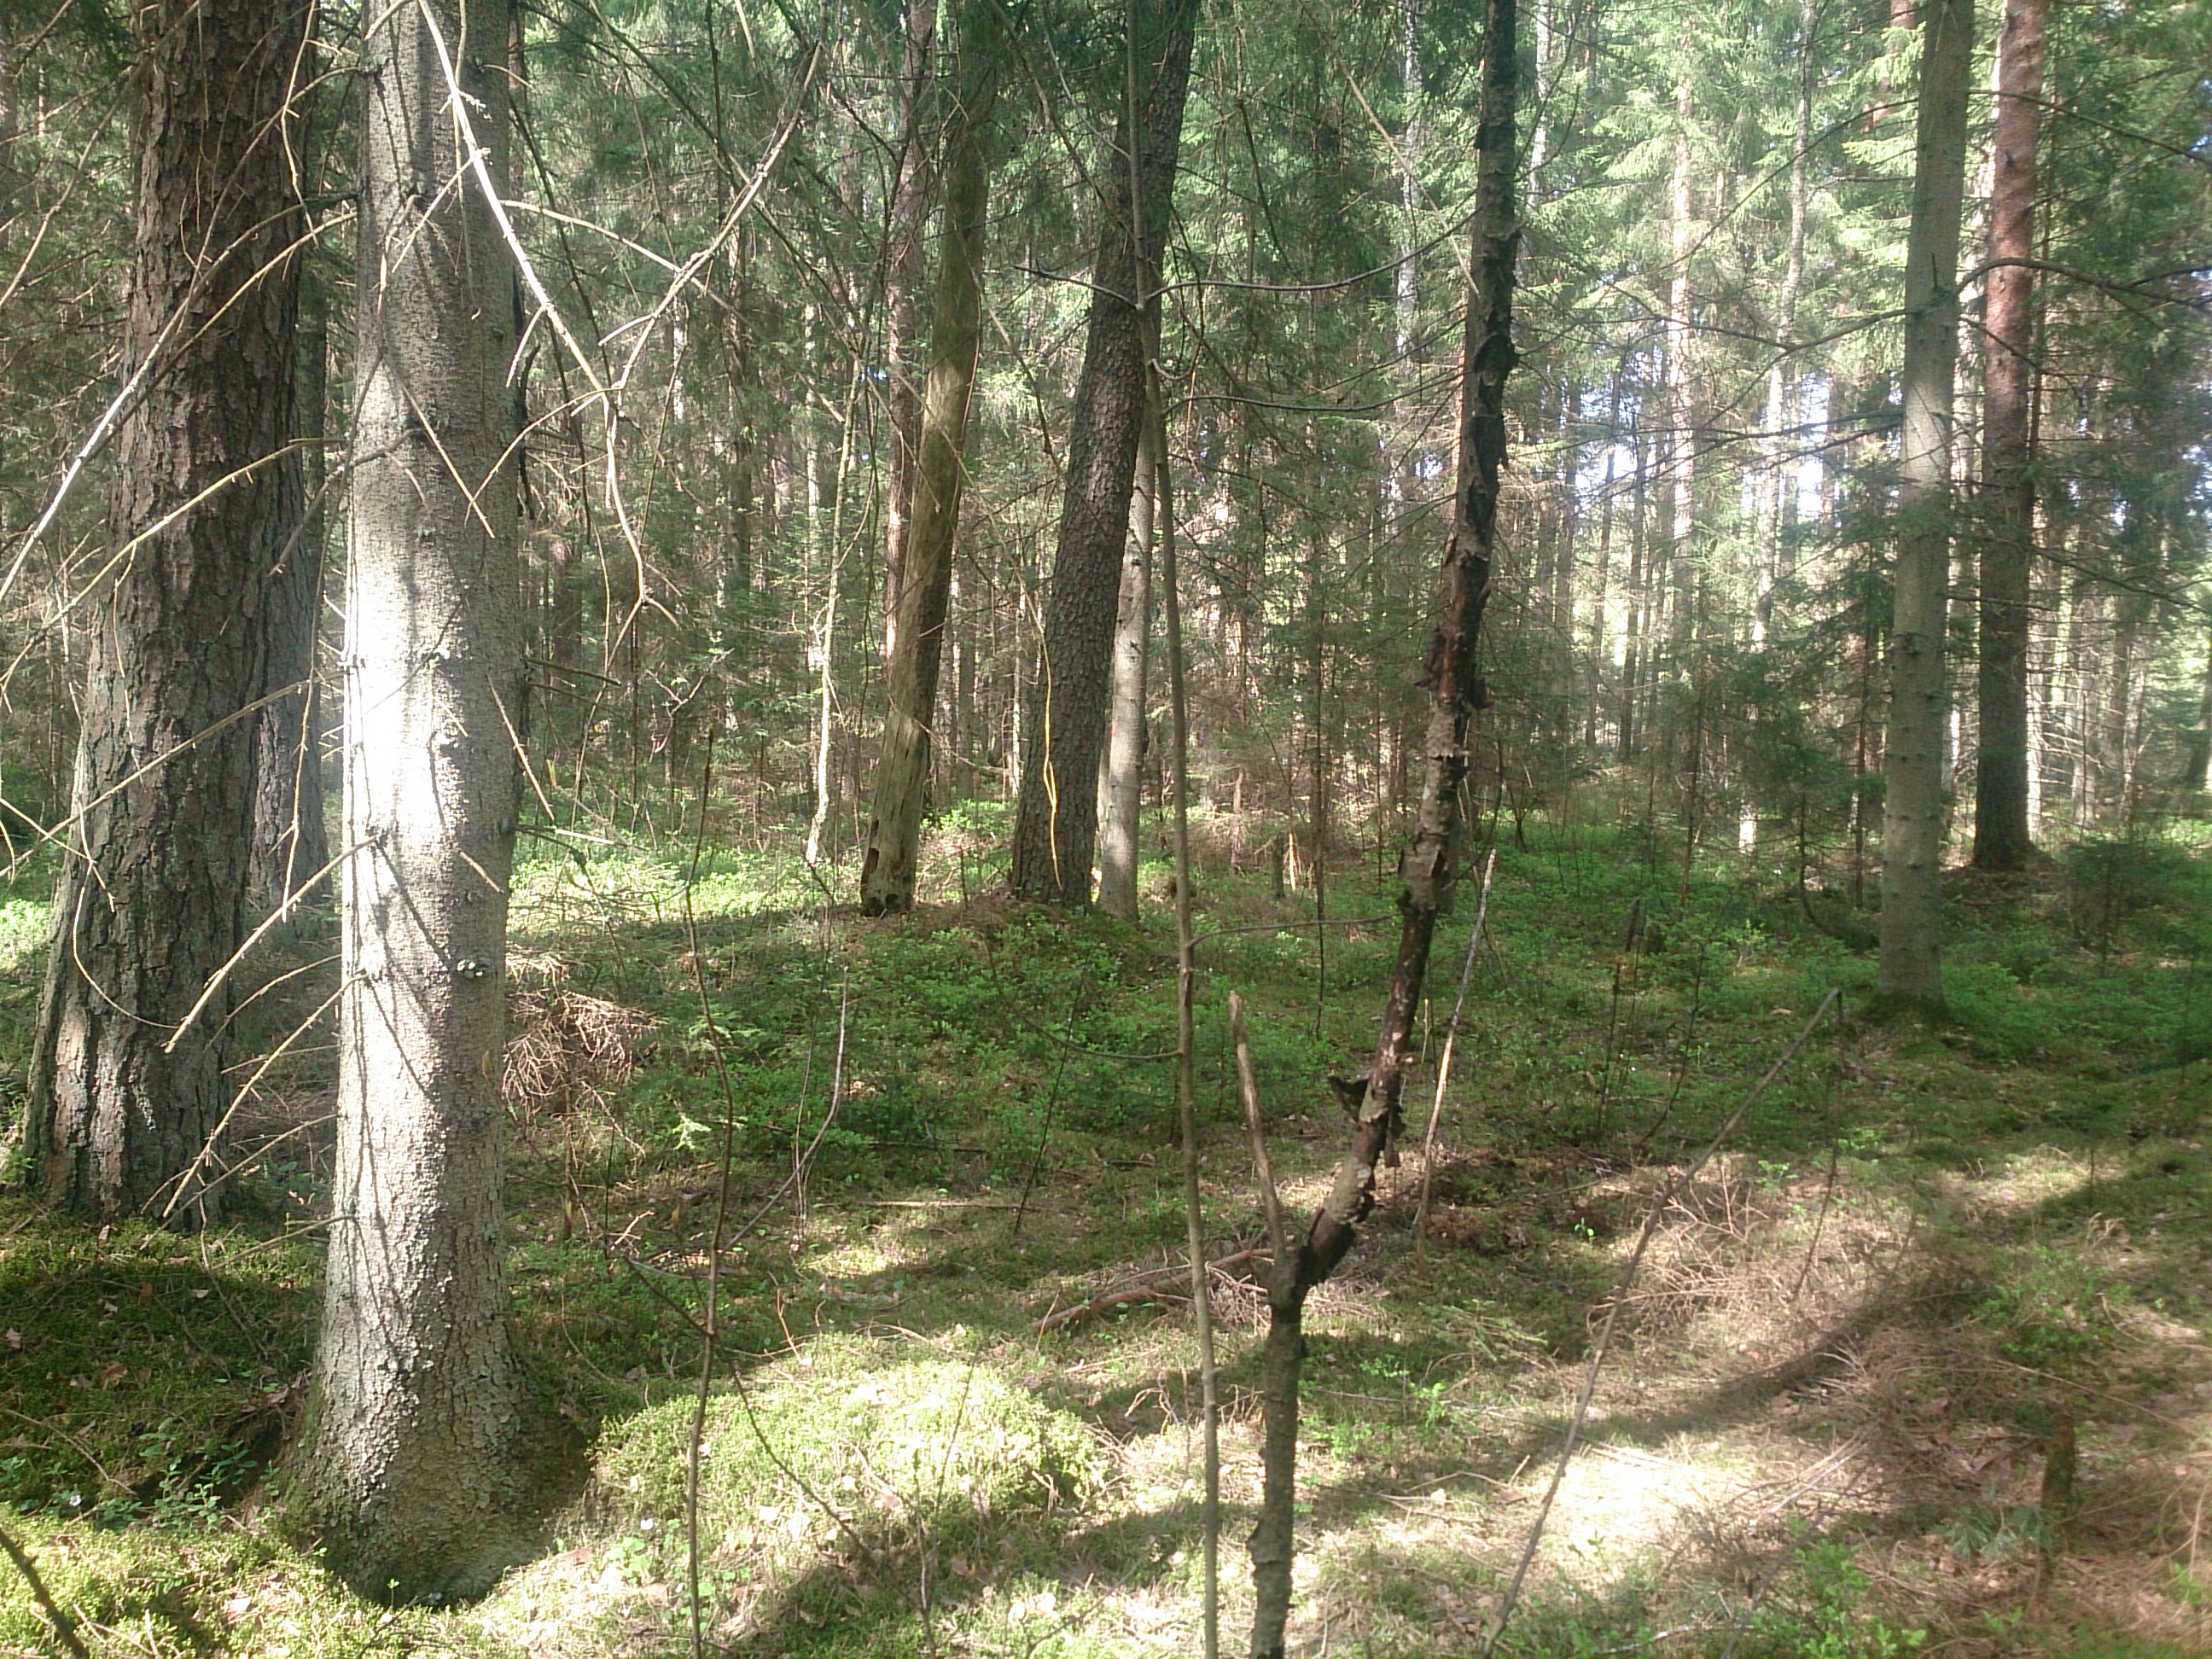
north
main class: Woodland
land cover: Other mixed woodland
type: hemiboreal forest and nemoral coniferous forest and mixed broadleaved-coniferous forest
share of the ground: > 75 %
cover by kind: coniferous forest trees 70 %, broadleaved forest trees 30 %
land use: Forestry
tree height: > 5 m
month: May
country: LV
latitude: 56.7955
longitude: 24.0844
